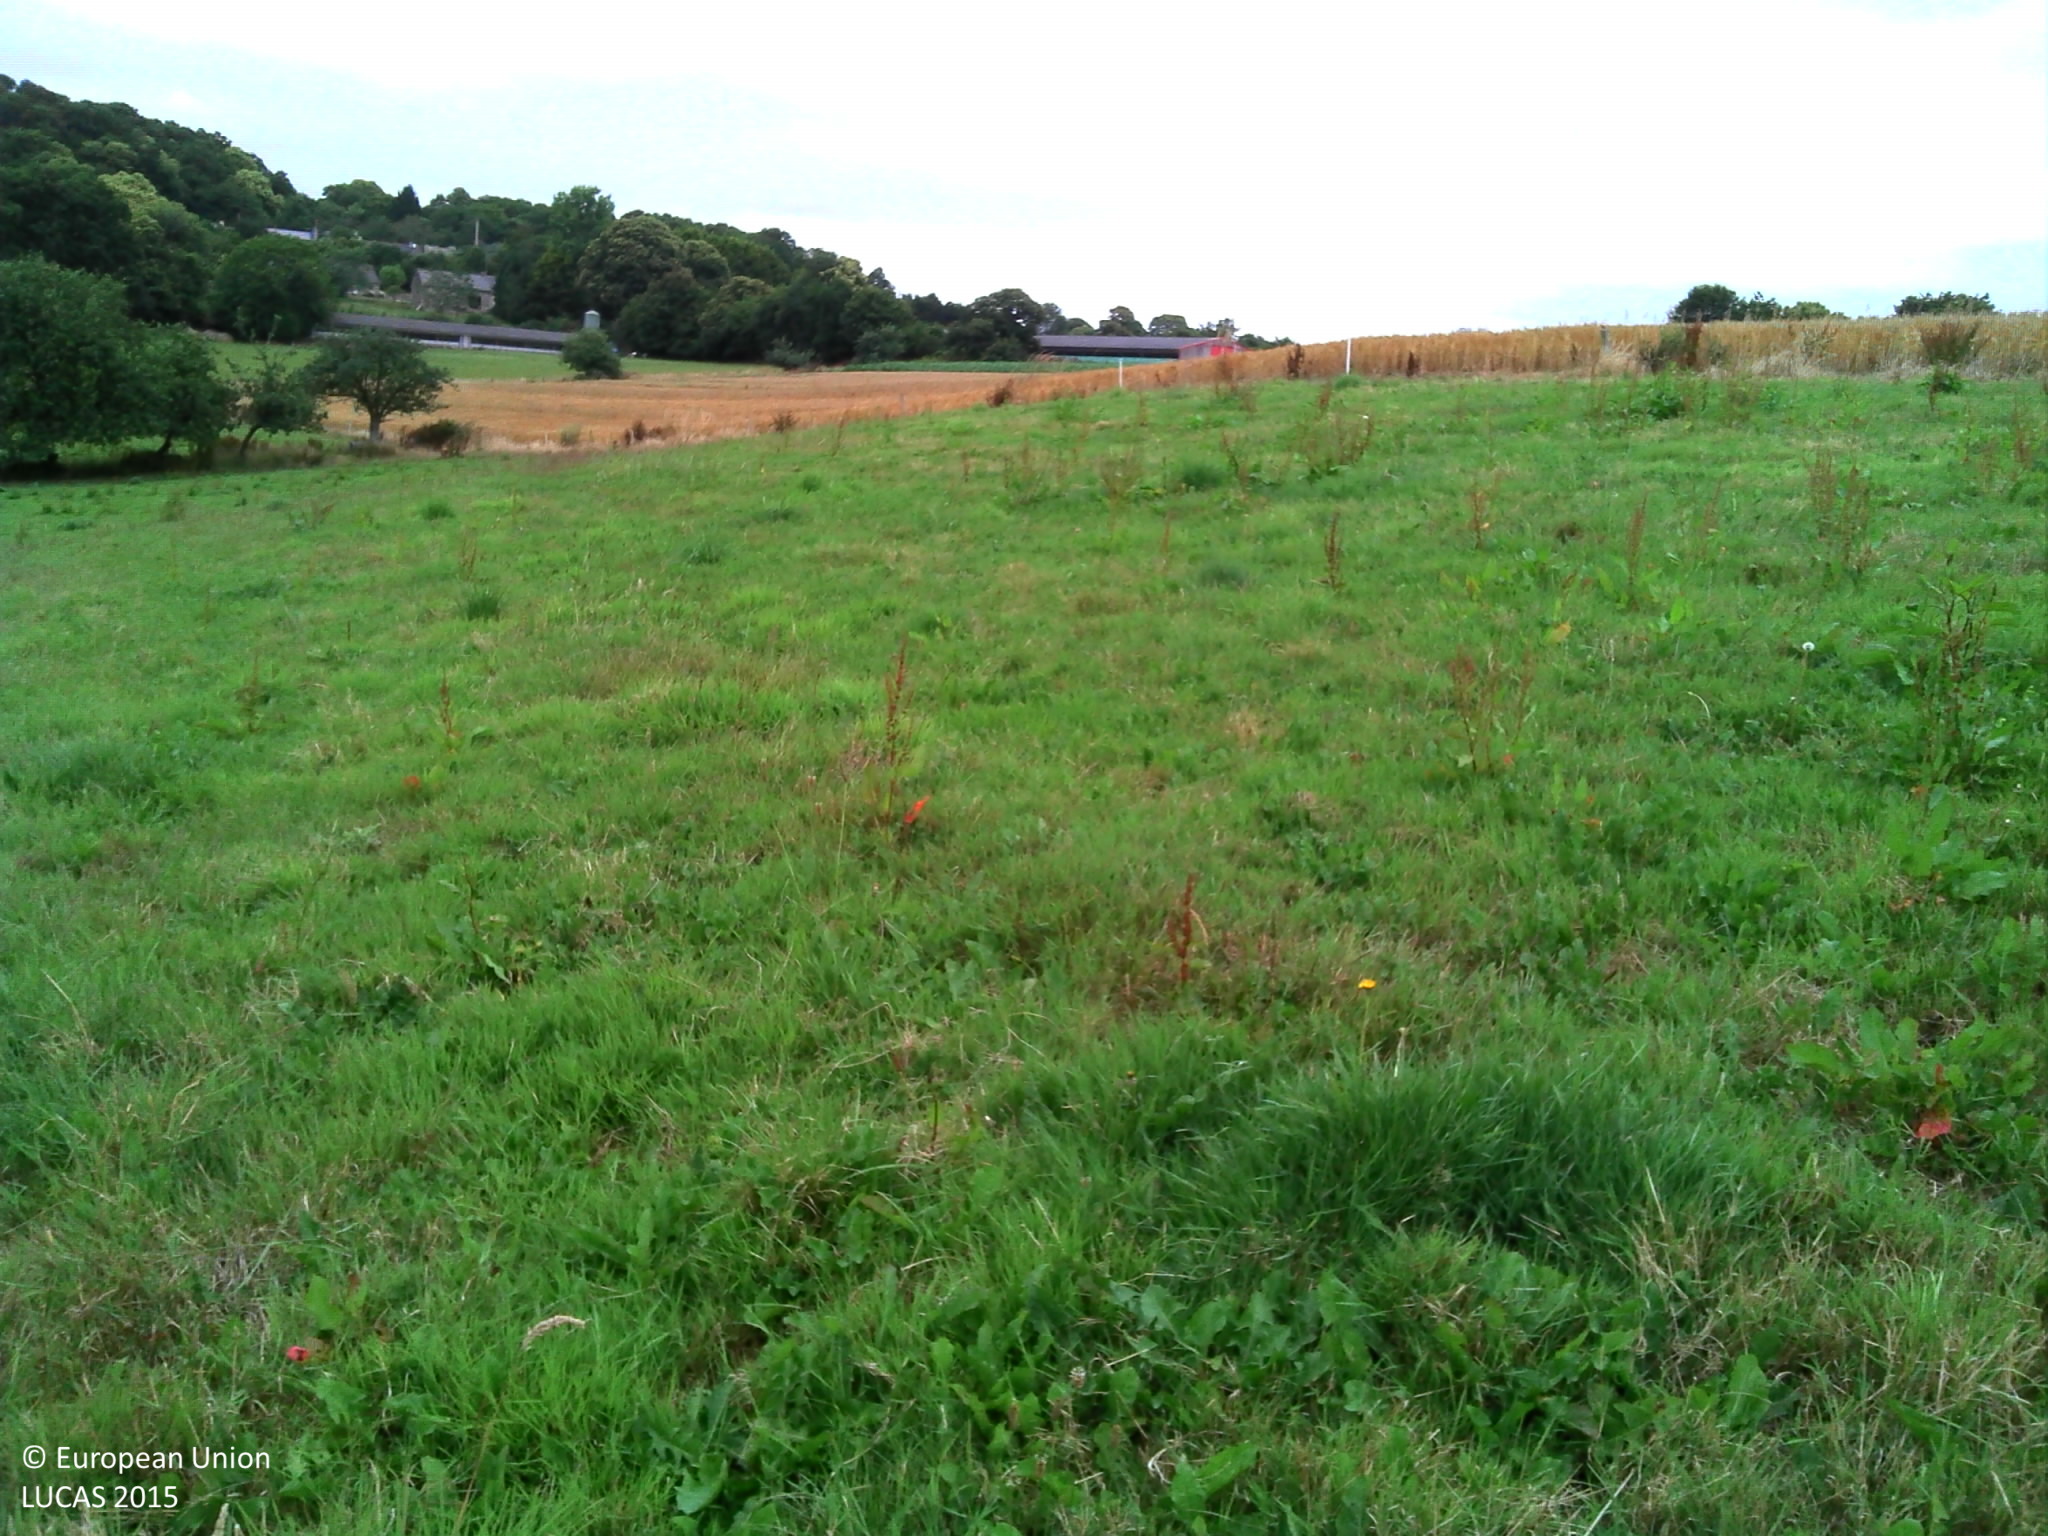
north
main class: Grassland
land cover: Grassland without tree/shrub cover
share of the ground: > 75 %
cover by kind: herbaceous plants 100 %
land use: Agriculture (excluding fallow land and kitchen gardens)
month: July
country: FR
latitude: 48.0987
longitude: -3.6559
